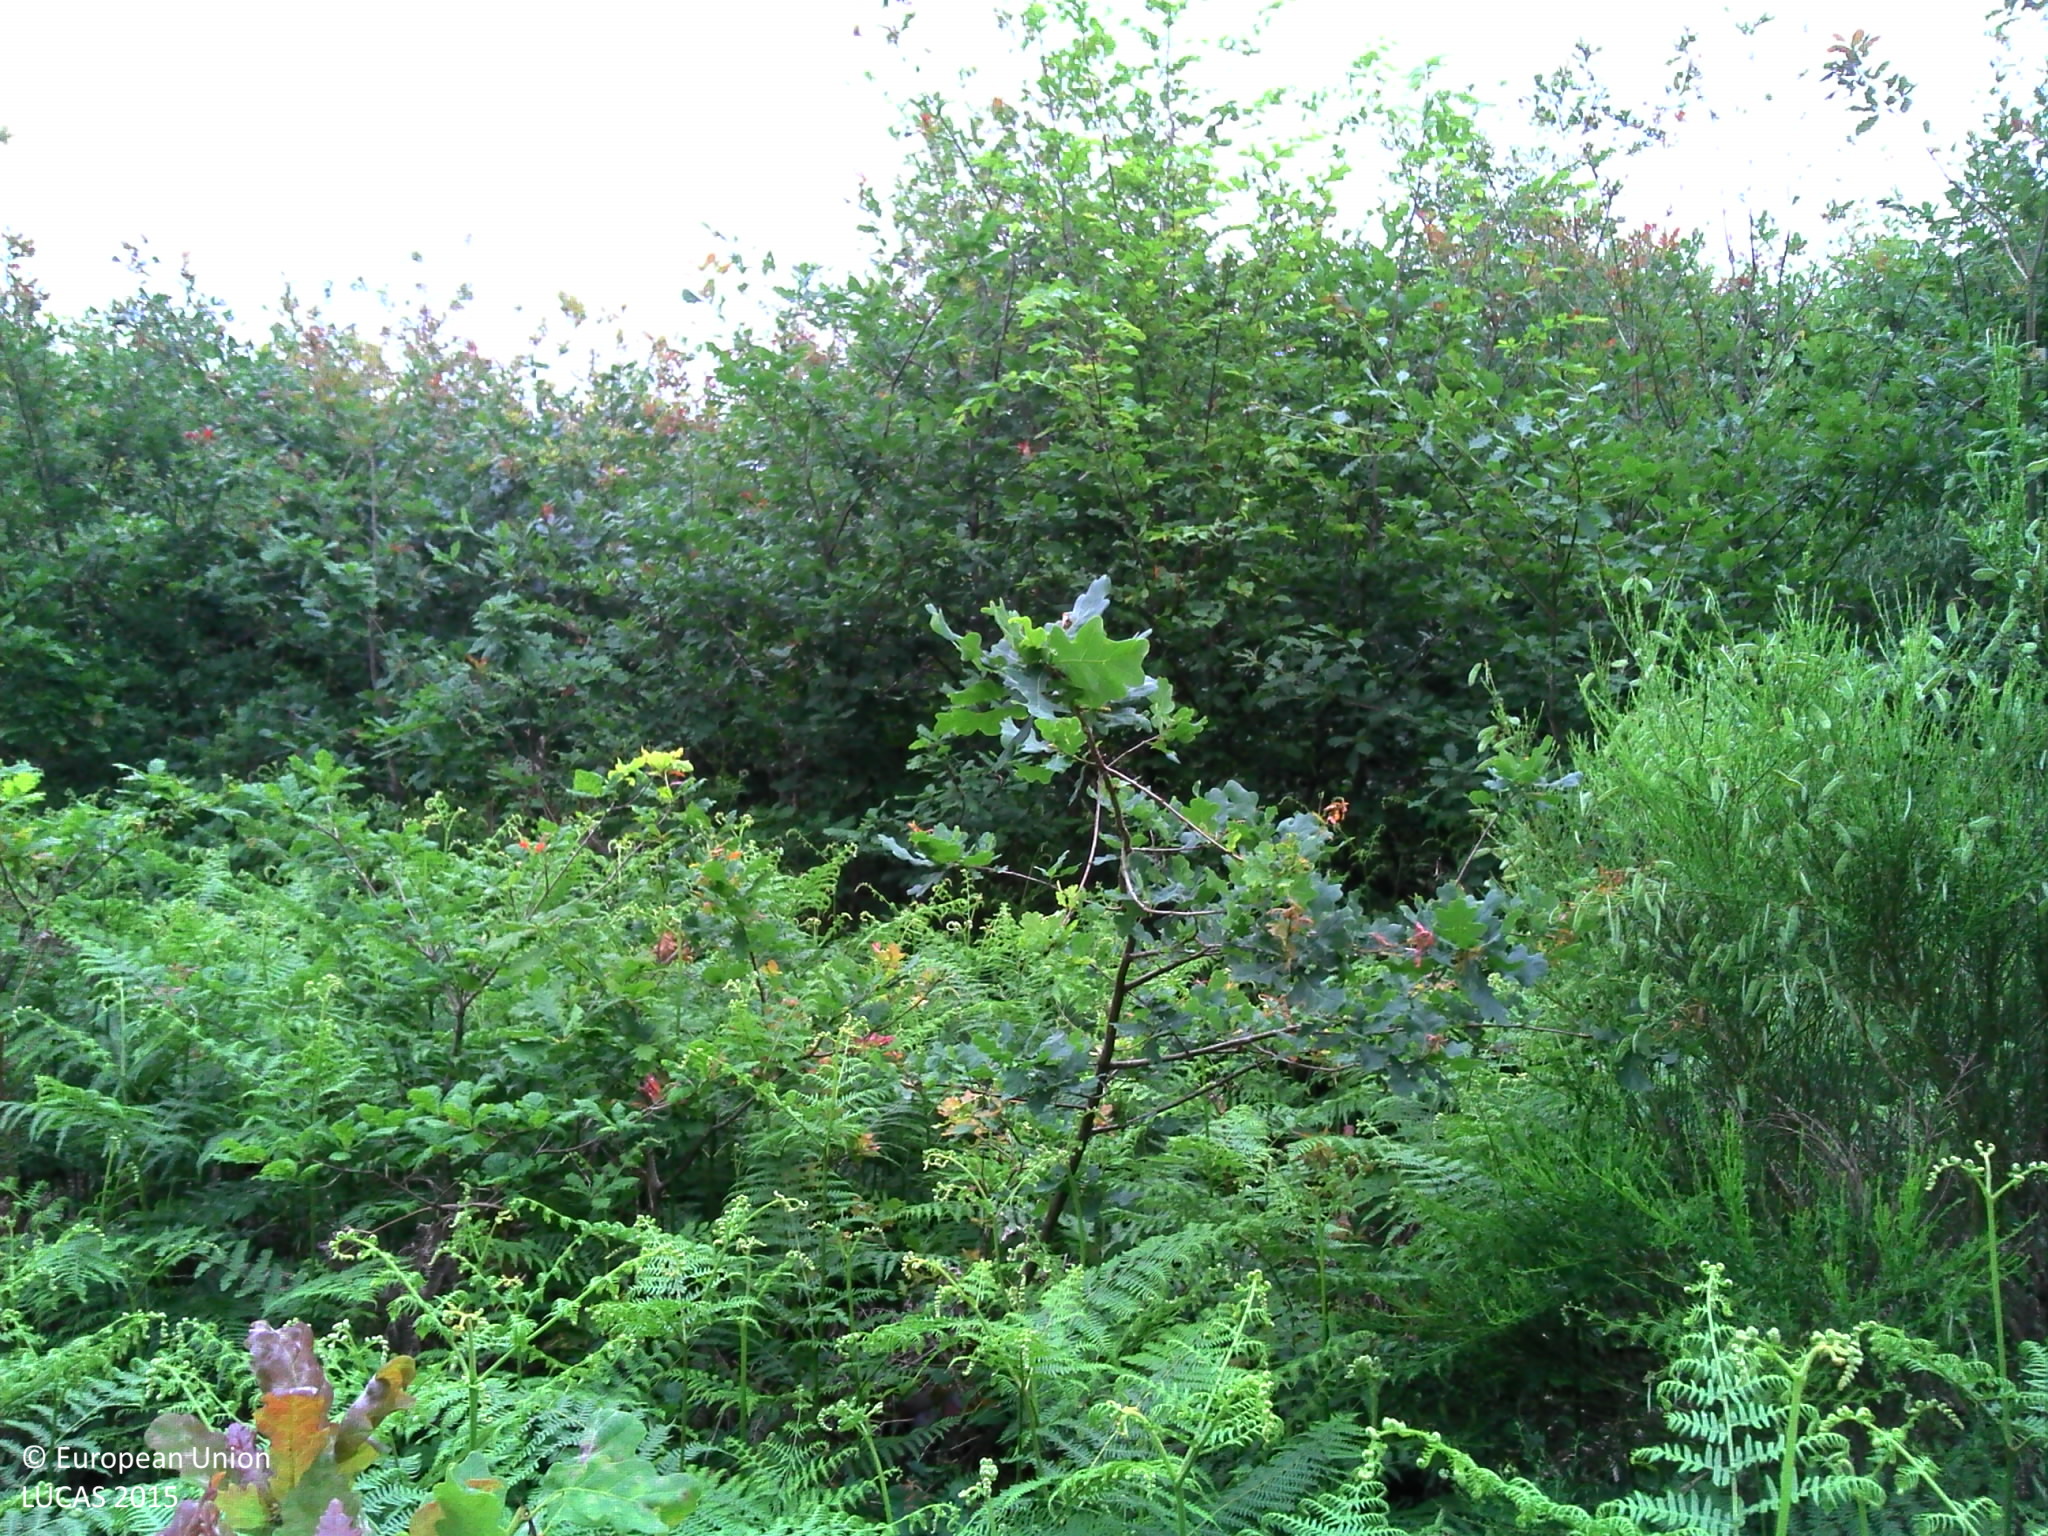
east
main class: Shrubland
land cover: Shrubland with sparse tree cover
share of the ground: > 75 %
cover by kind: shrubs 95 %, broadleaved forest trees 5 %
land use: Forestry
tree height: < 5 m
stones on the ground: < 10 %
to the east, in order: Shrubland with sparse tree cover; Broadleaved woodland; Shrubland with sparse tree cover
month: June
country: FR
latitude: 46.6238
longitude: 2.6688
